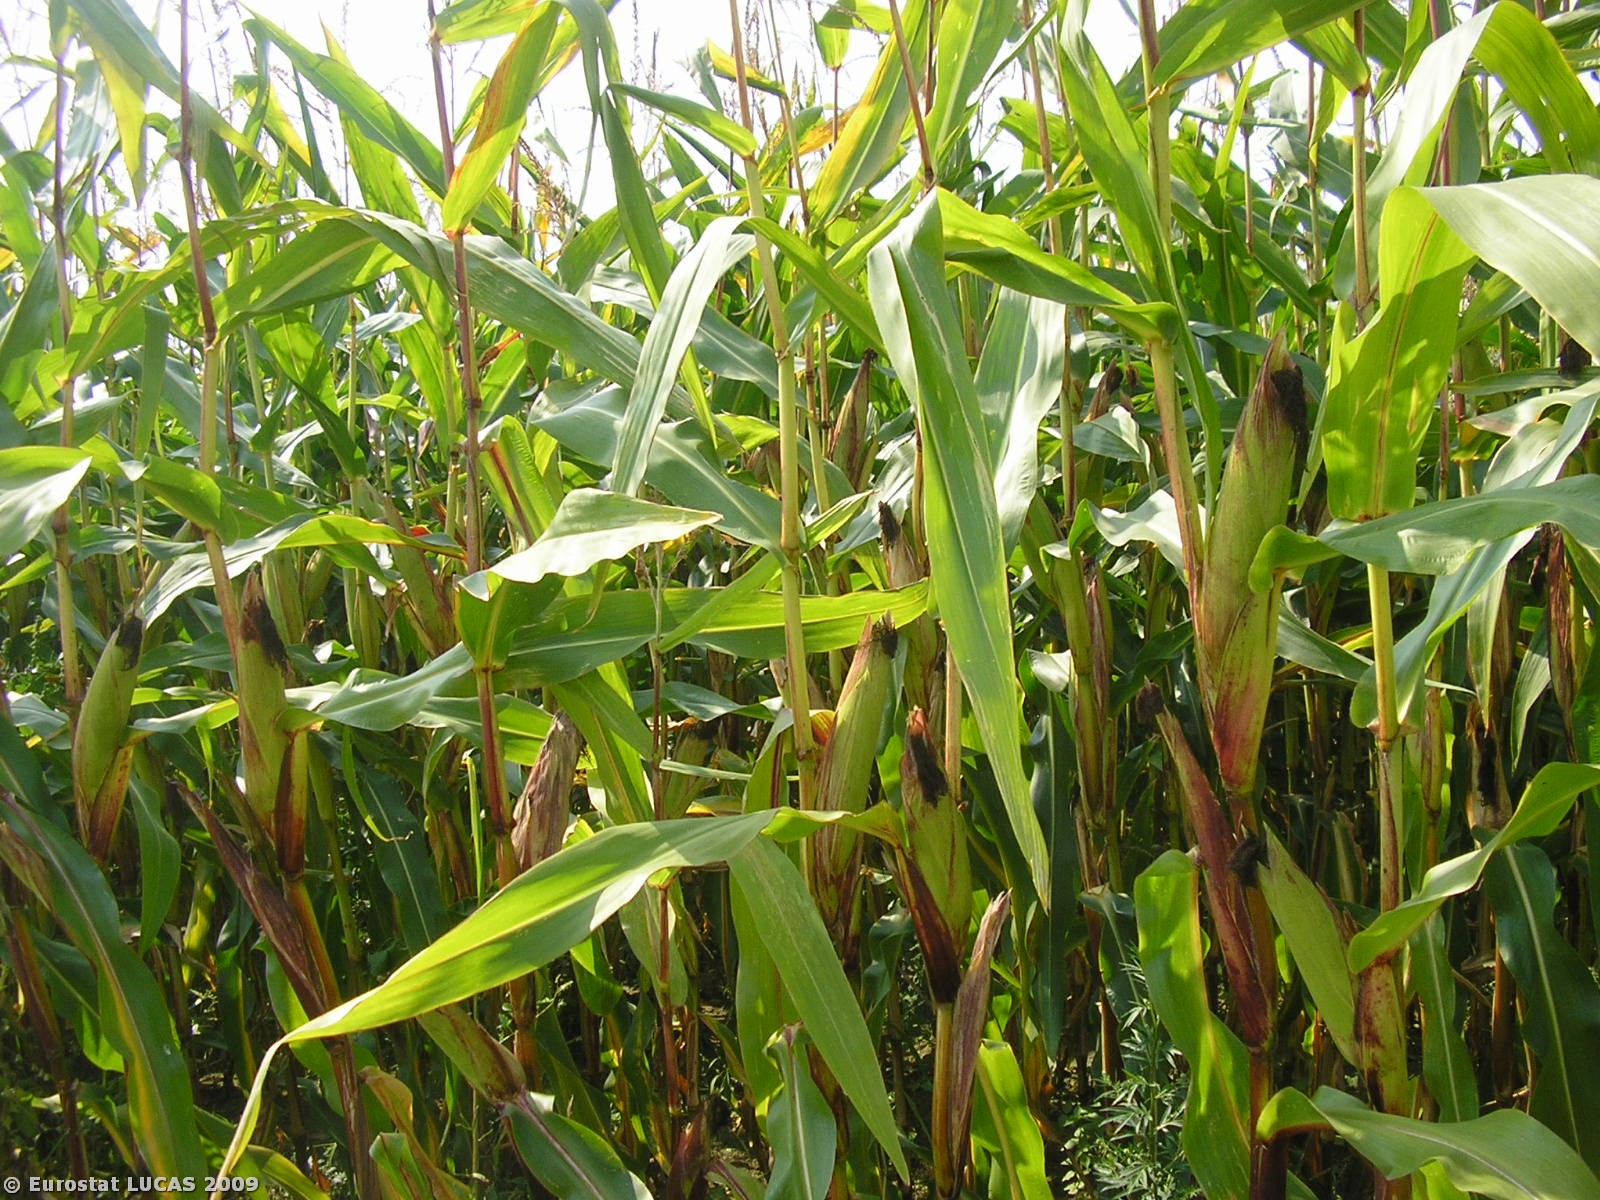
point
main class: Cropland
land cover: Maize
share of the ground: > 75 %
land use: Agriculture (excluding fallow land and kitchen gardens)
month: September
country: PL
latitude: 52.1326
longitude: 19.5976
